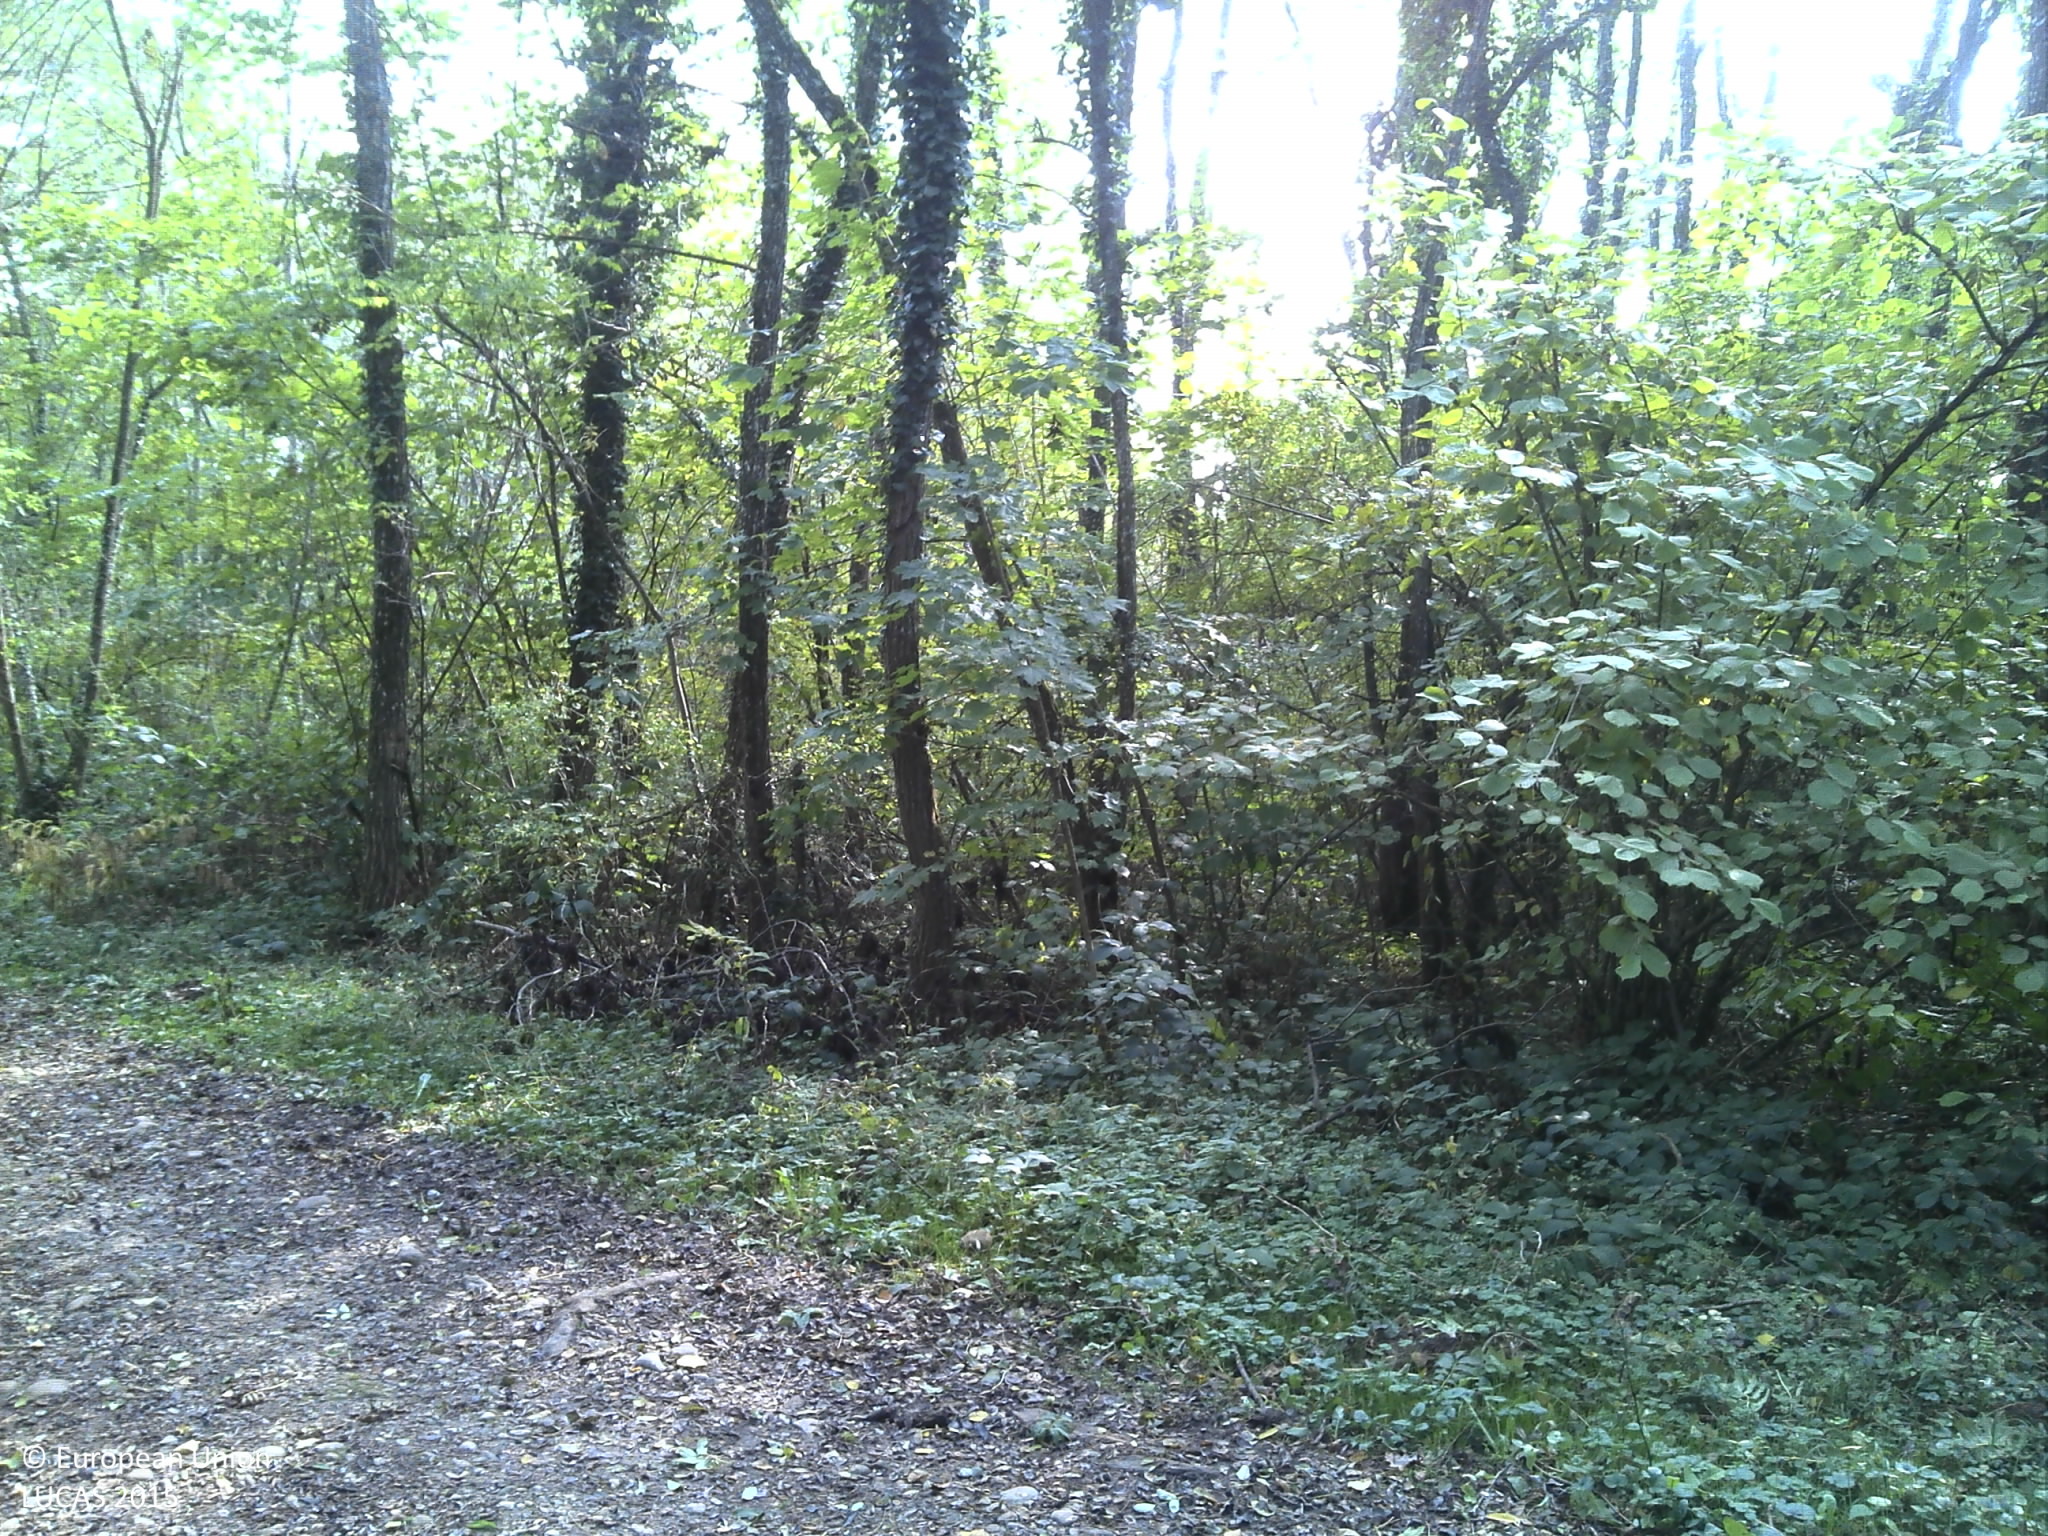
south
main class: Woodland
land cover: Broadleaved woodland
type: mesophytic deciduous forest
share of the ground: > 75 %
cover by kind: broadleaved forest trees 90 %, herbaceous plants 5 %, unconsolidated bare surface 5 %
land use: Forestry
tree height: > 5 m
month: October
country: FR
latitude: 45.9433
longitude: 5.3470
